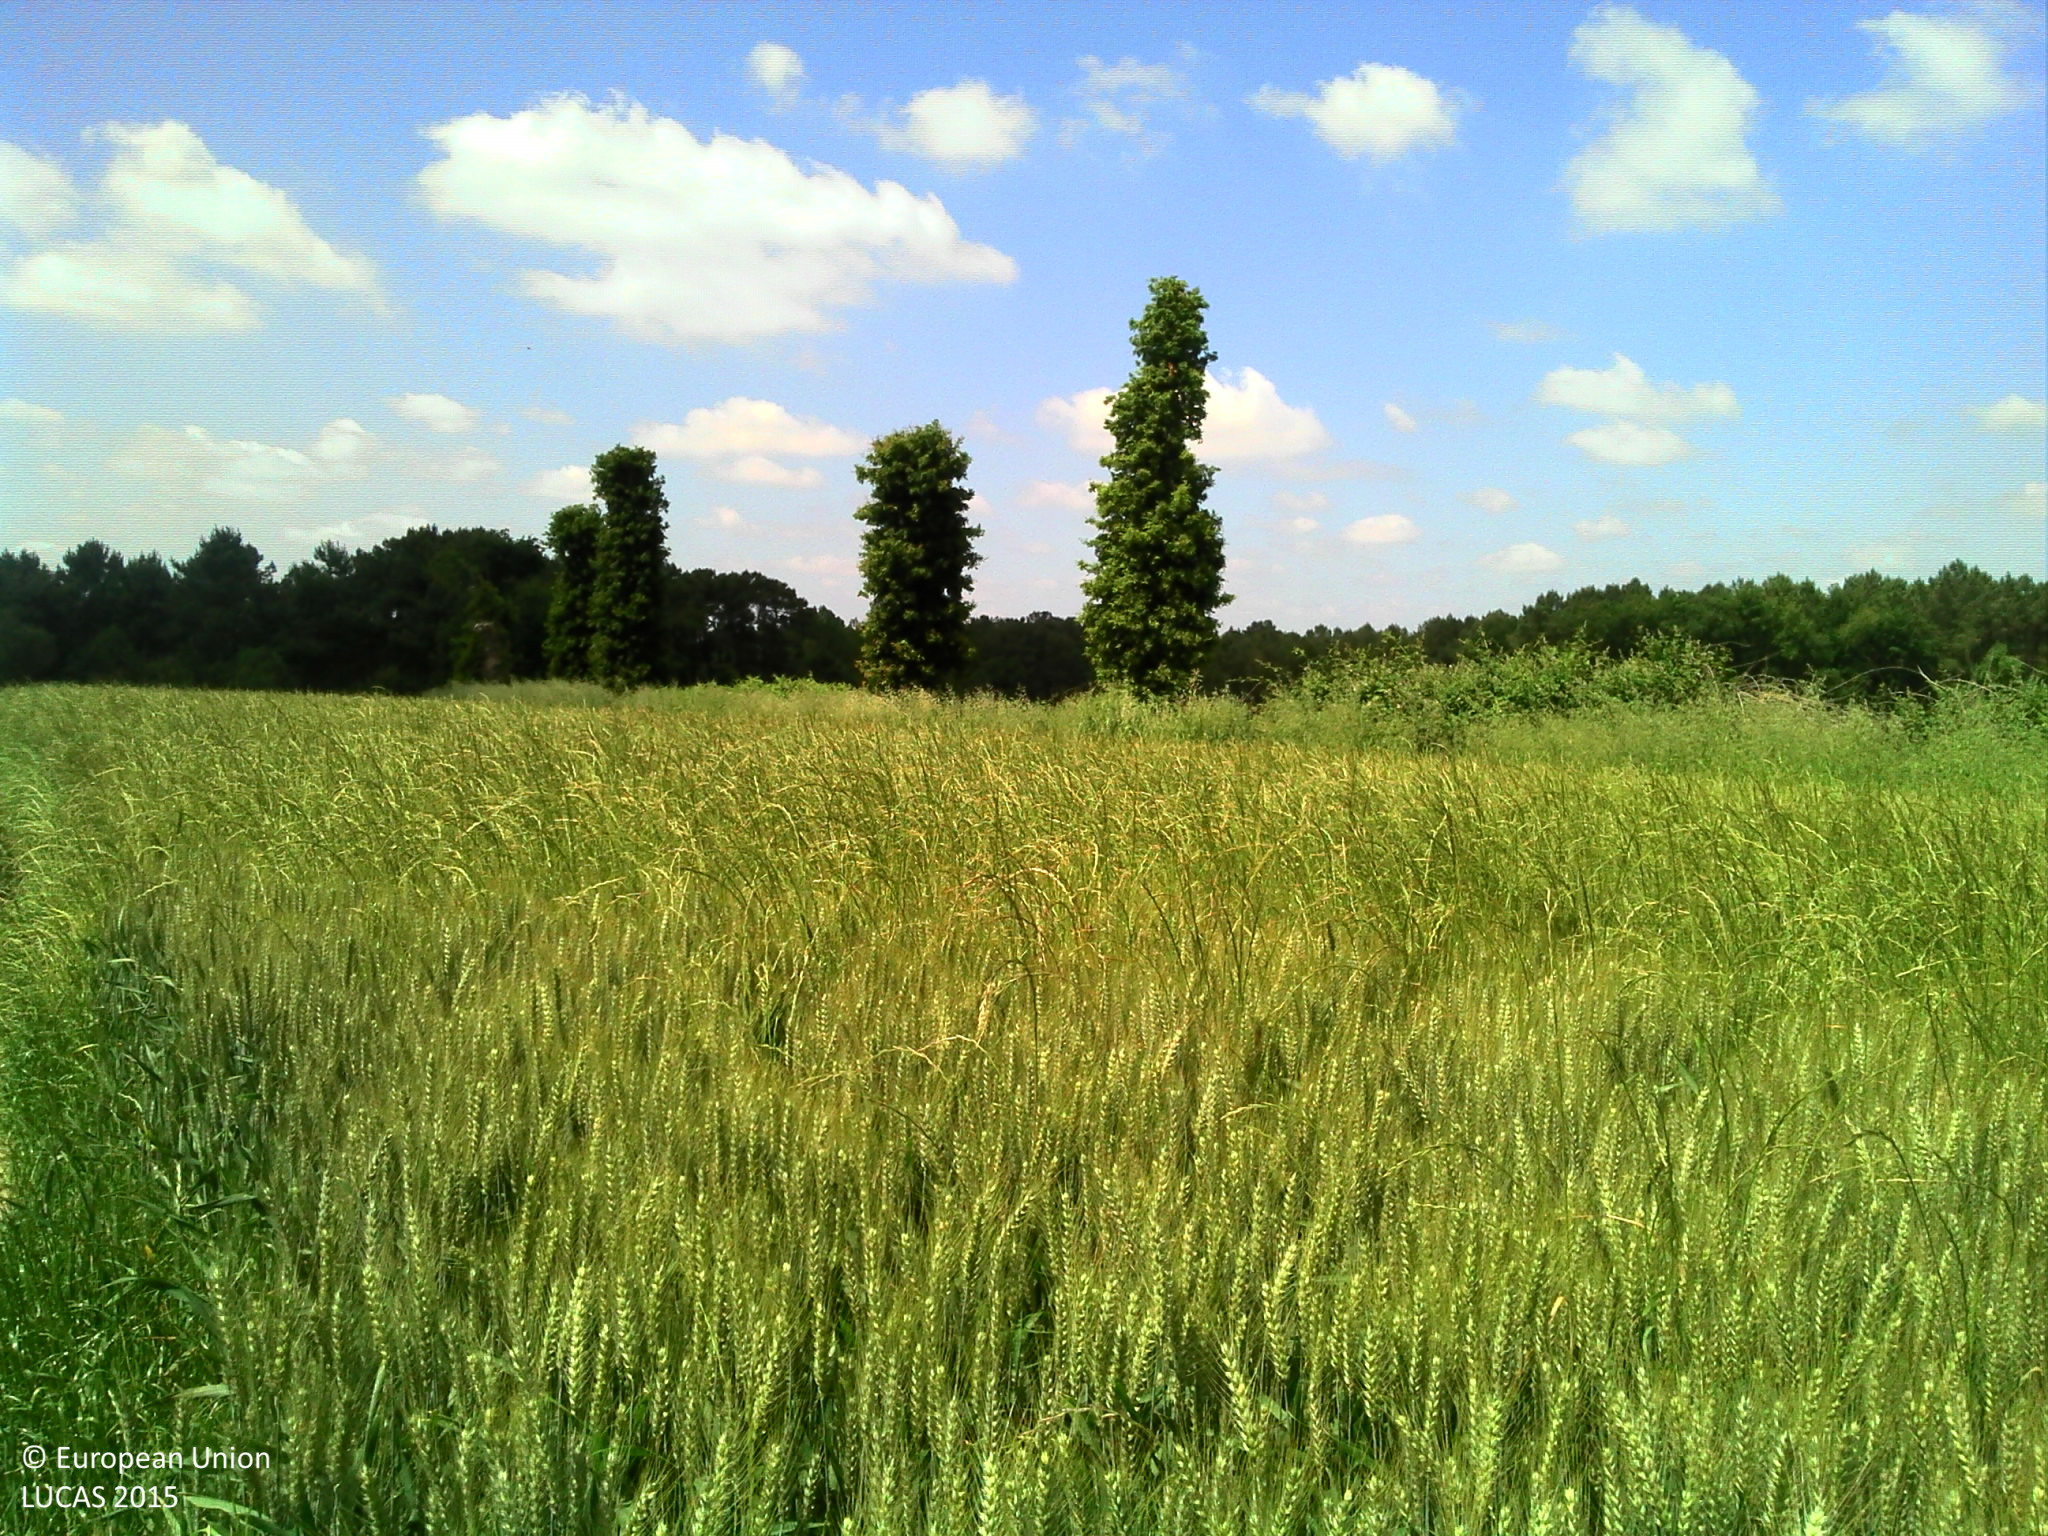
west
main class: Cropland
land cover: Common wheat
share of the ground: > 75 %
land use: Agriculture (excluding fallow land and kitchen gardens)
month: June
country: FR
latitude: 47.9964
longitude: -1.8840
